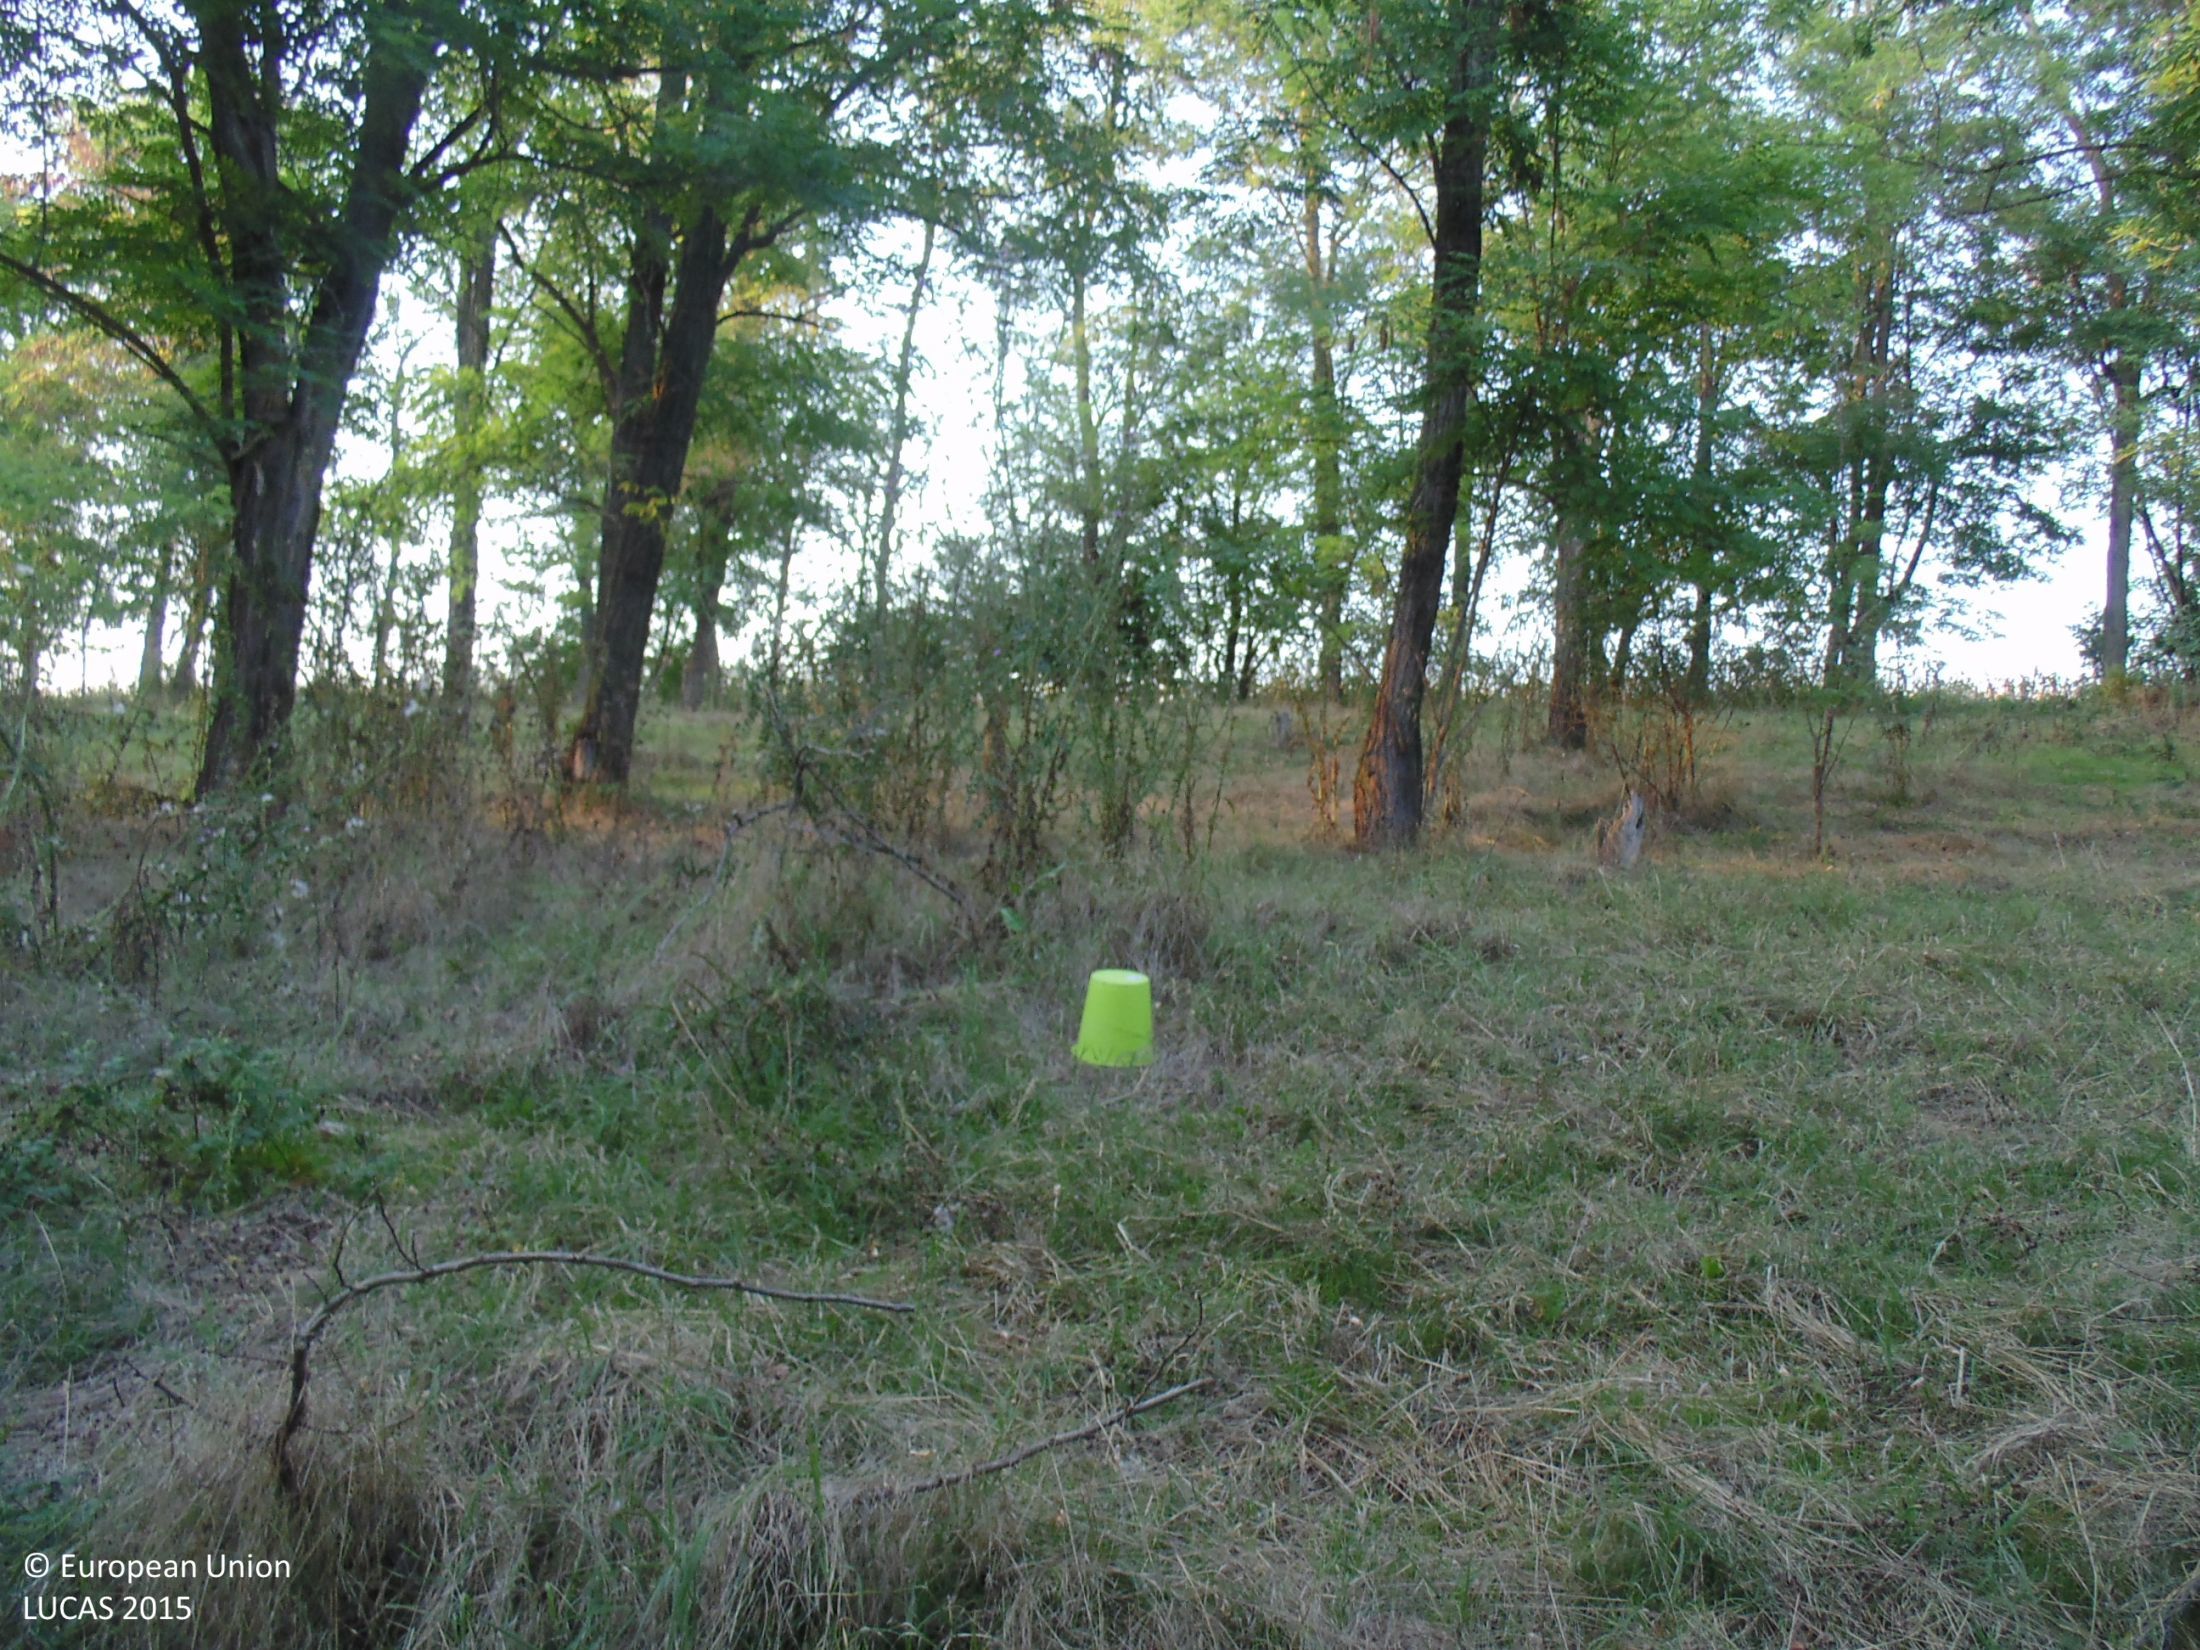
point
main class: Woodland
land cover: Broadleaved woodland
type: mesophytic deciduous forest
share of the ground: > 75 %
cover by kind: broadleaved forest trees 80 %, shrubs 15 %, unconsolidated bare surface 5 %
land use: Forestry
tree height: > 5 m
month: August
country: BG
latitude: 43.6805
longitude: 27.4868
